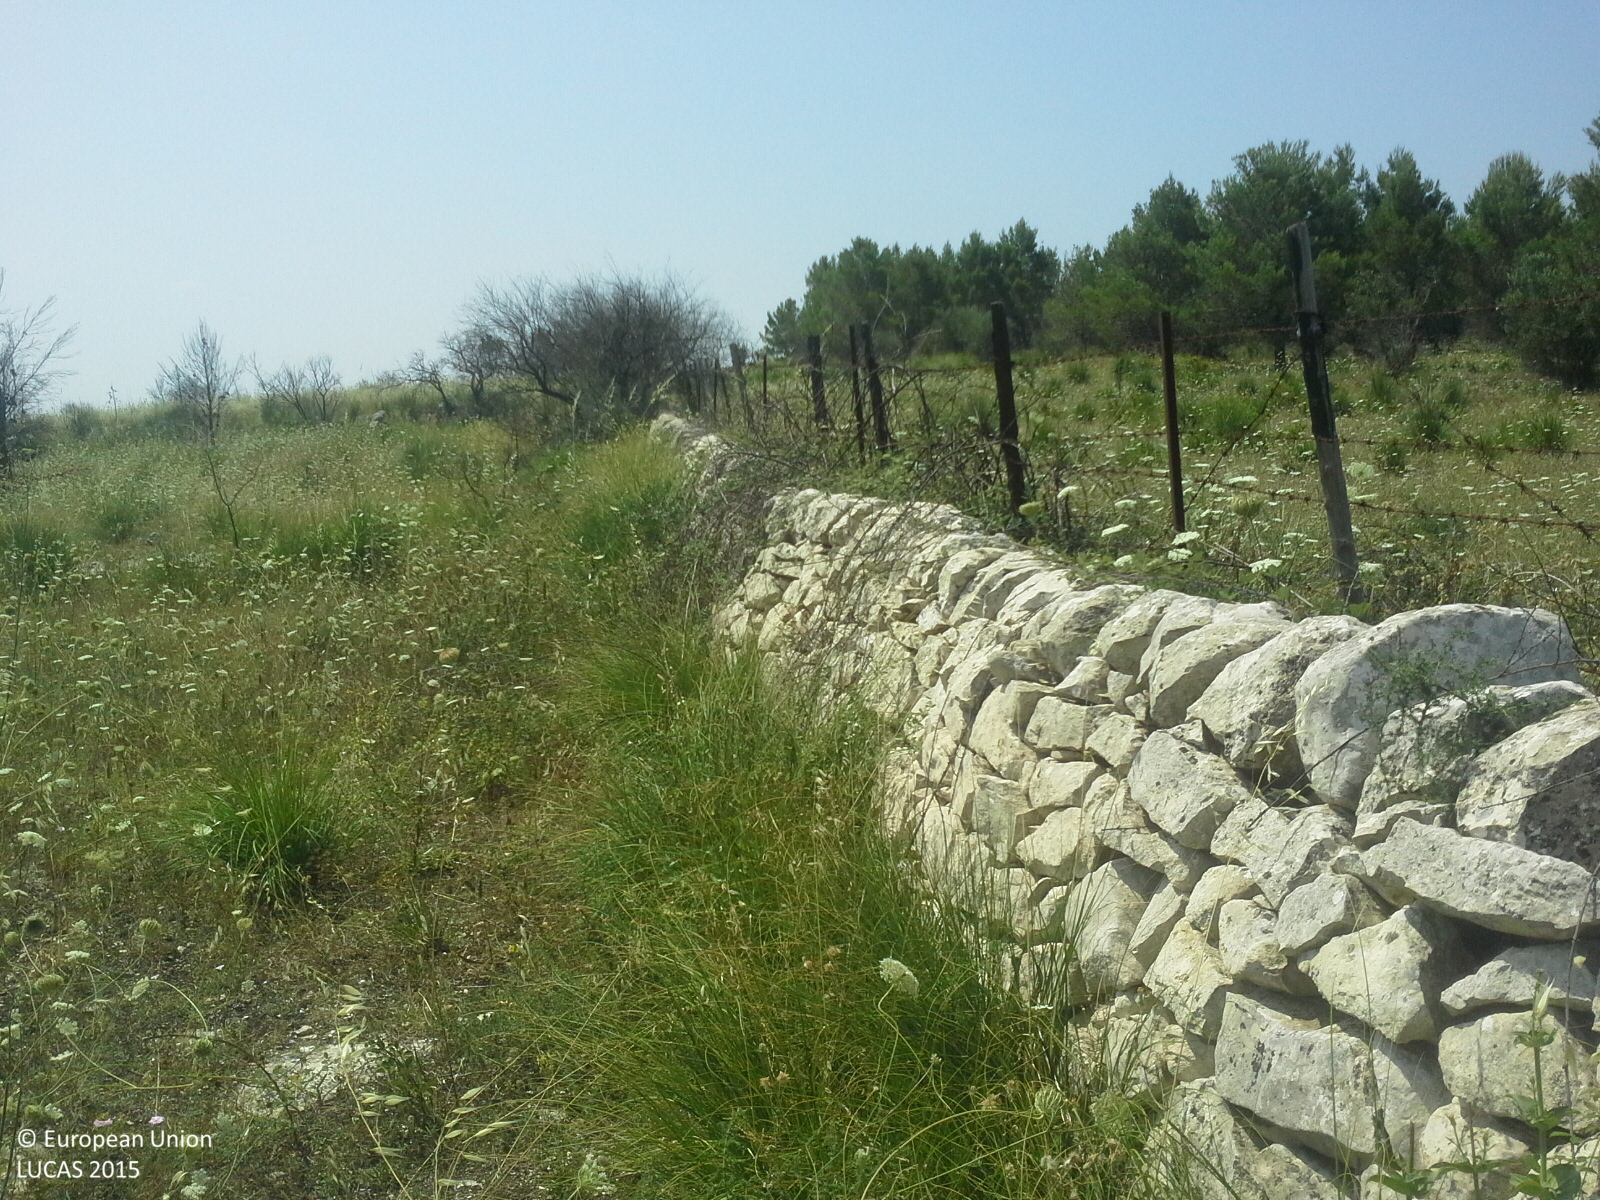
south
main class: Shrubland
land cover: Shrubland with sparse tree cover
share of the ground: > 75 %
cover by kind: shrubs 90 %, coniferous forest trees 5 %, herbaceous plants 5 %
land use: Agriculture (excluding fallow land and kitchen gardens)
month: July
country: IT
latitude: 37.0076
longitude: 14.8061
